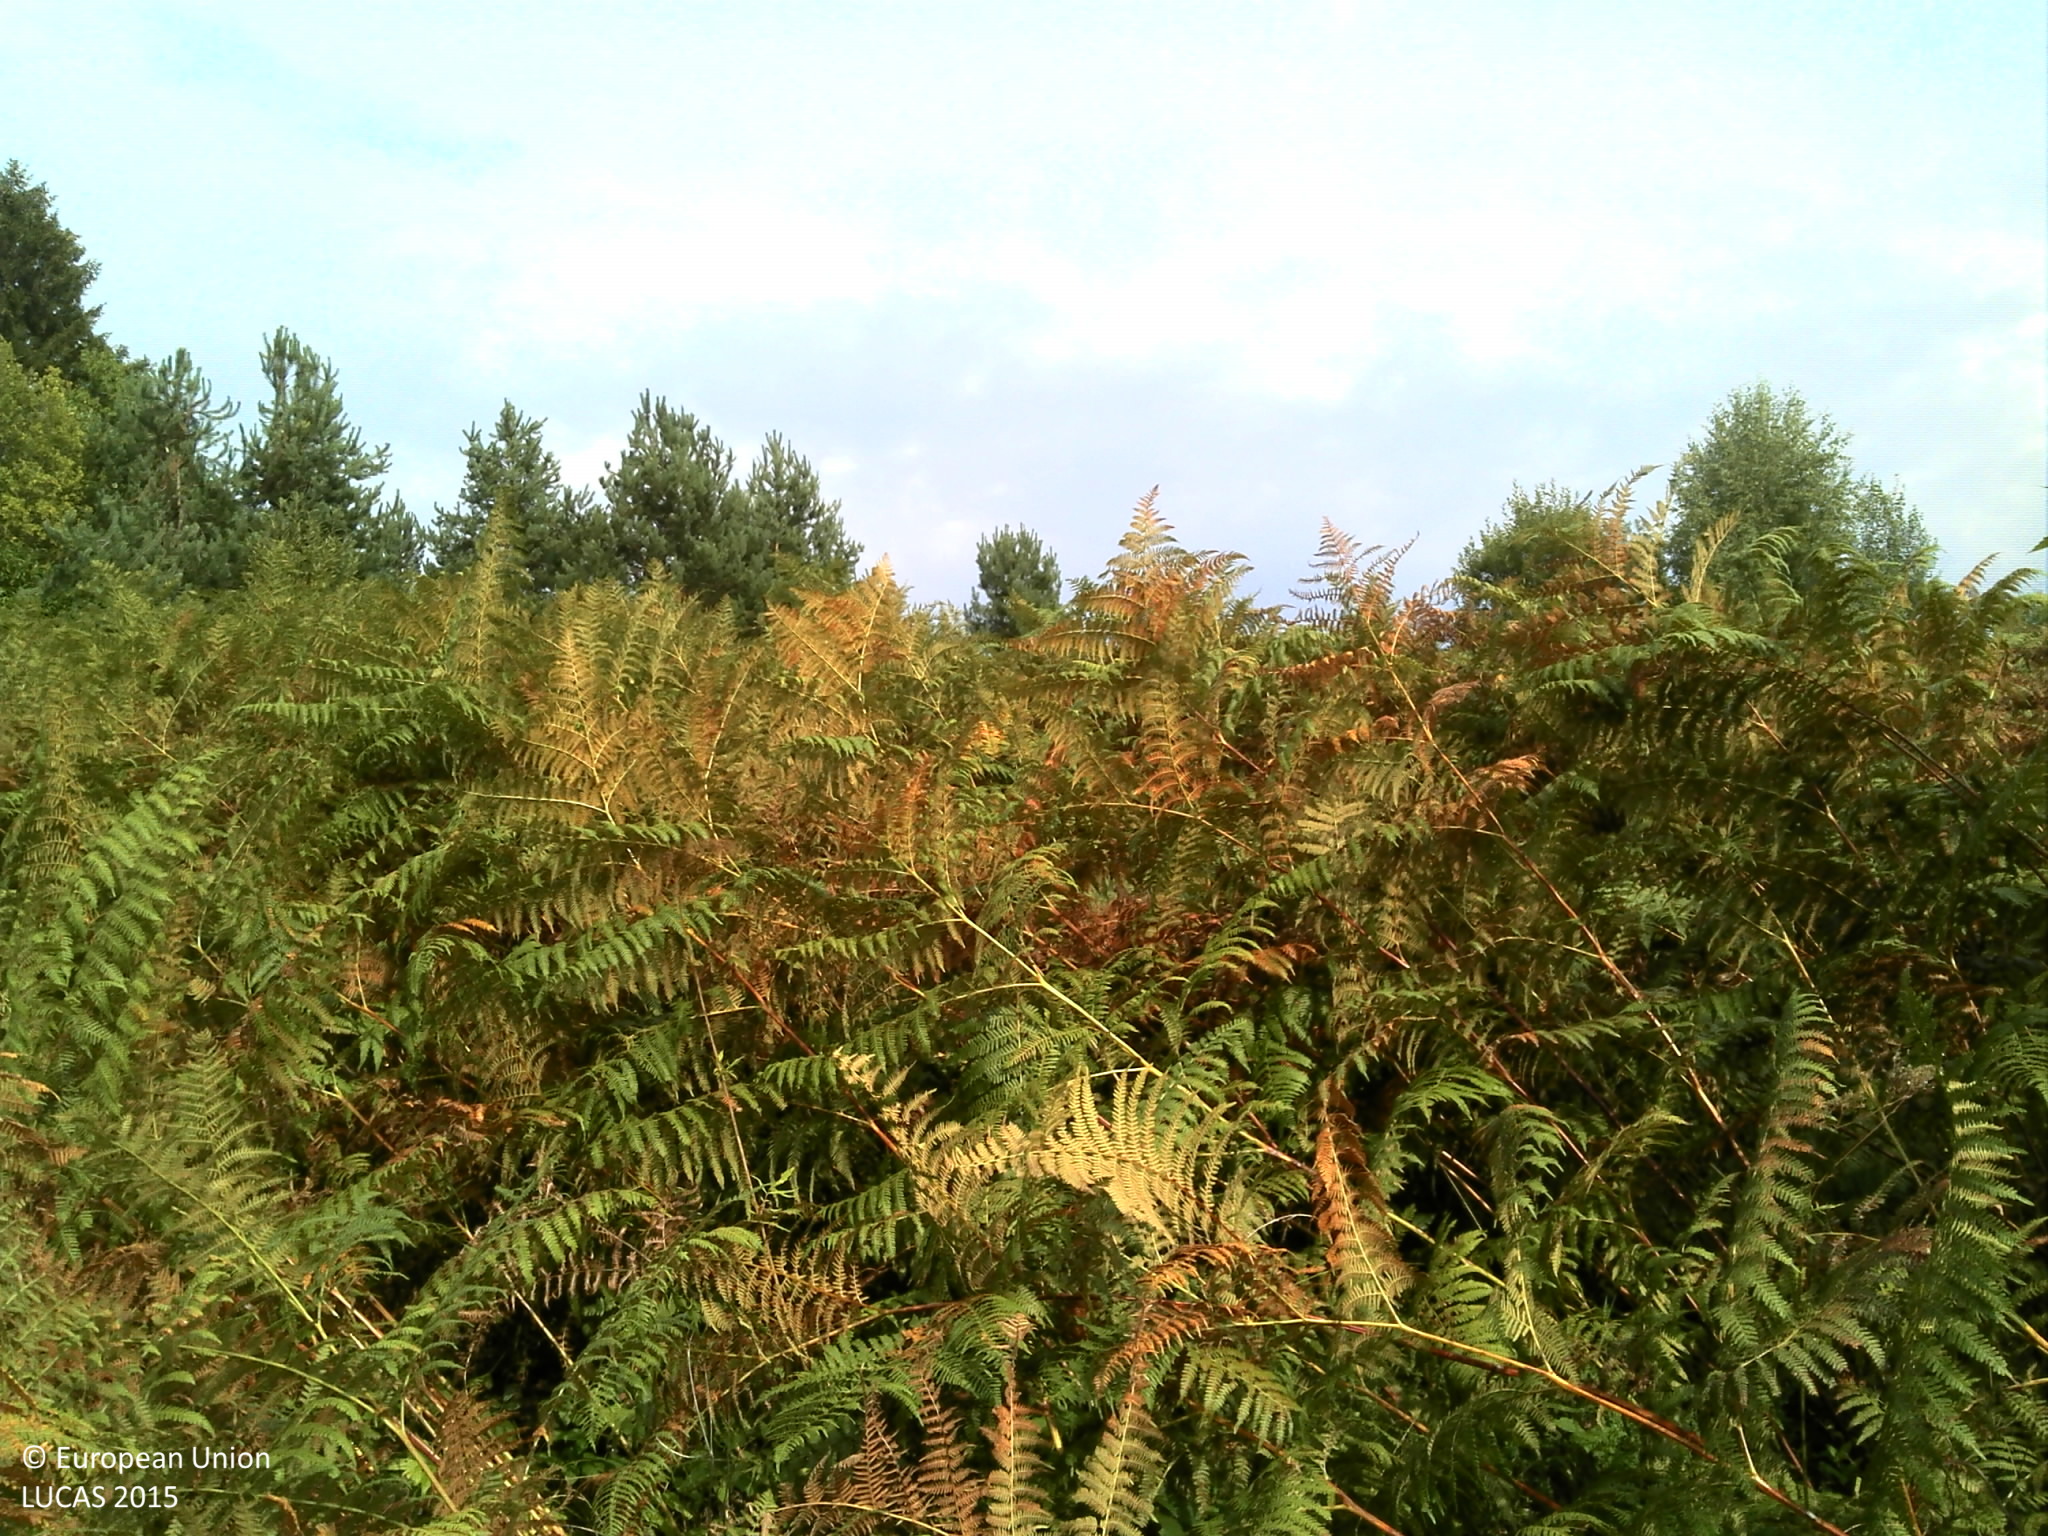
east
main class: Shrubland
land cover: Shrubland without tree cover
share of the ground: > 75 %
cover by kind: shrubs 100 %
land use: Semi-natural and natural areas not in use
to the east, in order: Shrubland without tree cover; Grassland without tree/shrub cover; Shrubland without tree cover; Grassland with sparse tree/shrub cover; Electric lines; Artificial constructions in urban areas; Other fruit trees and berries
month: September
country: HR
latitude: 45.1361
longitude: 15.6540
